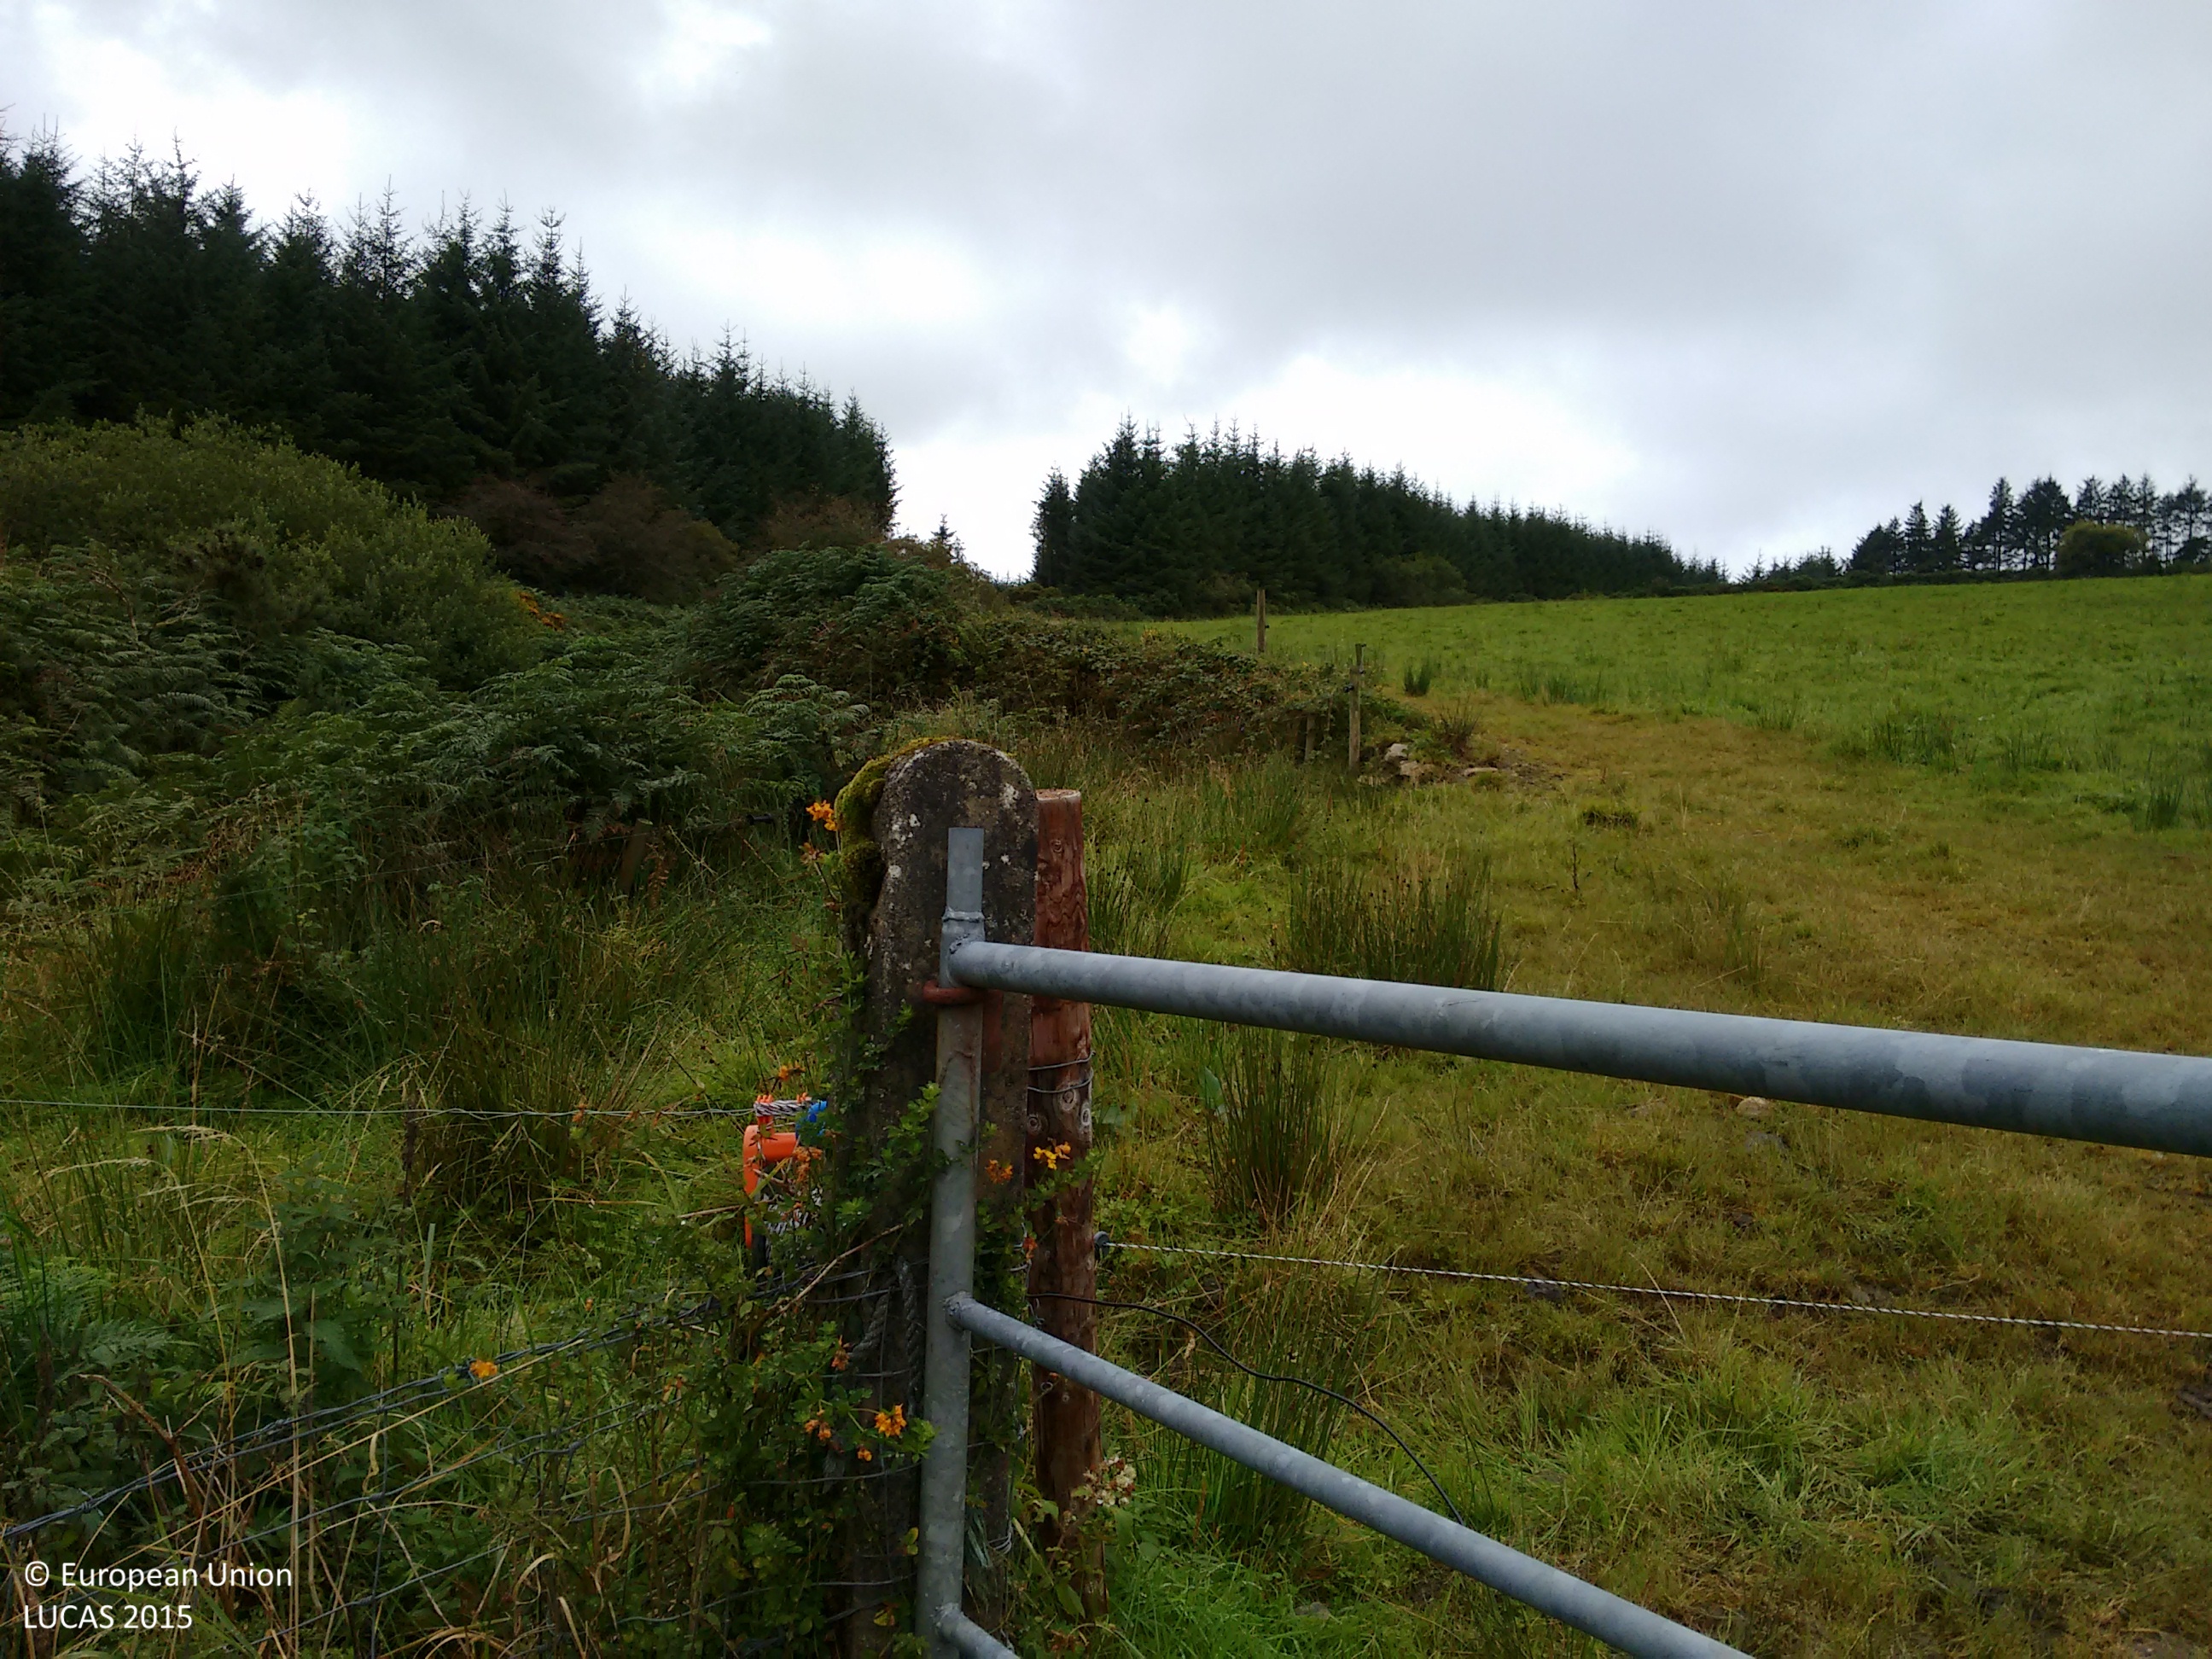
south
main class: Grassland
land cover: Grassland without tree/shrub cover
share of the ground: > 75 %
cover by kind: herbaceous plants 100 %
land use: Agriculture (excluding fallow land and kitchen gardens)
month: September
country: IE
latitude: 52.2567
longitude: -9.1618
